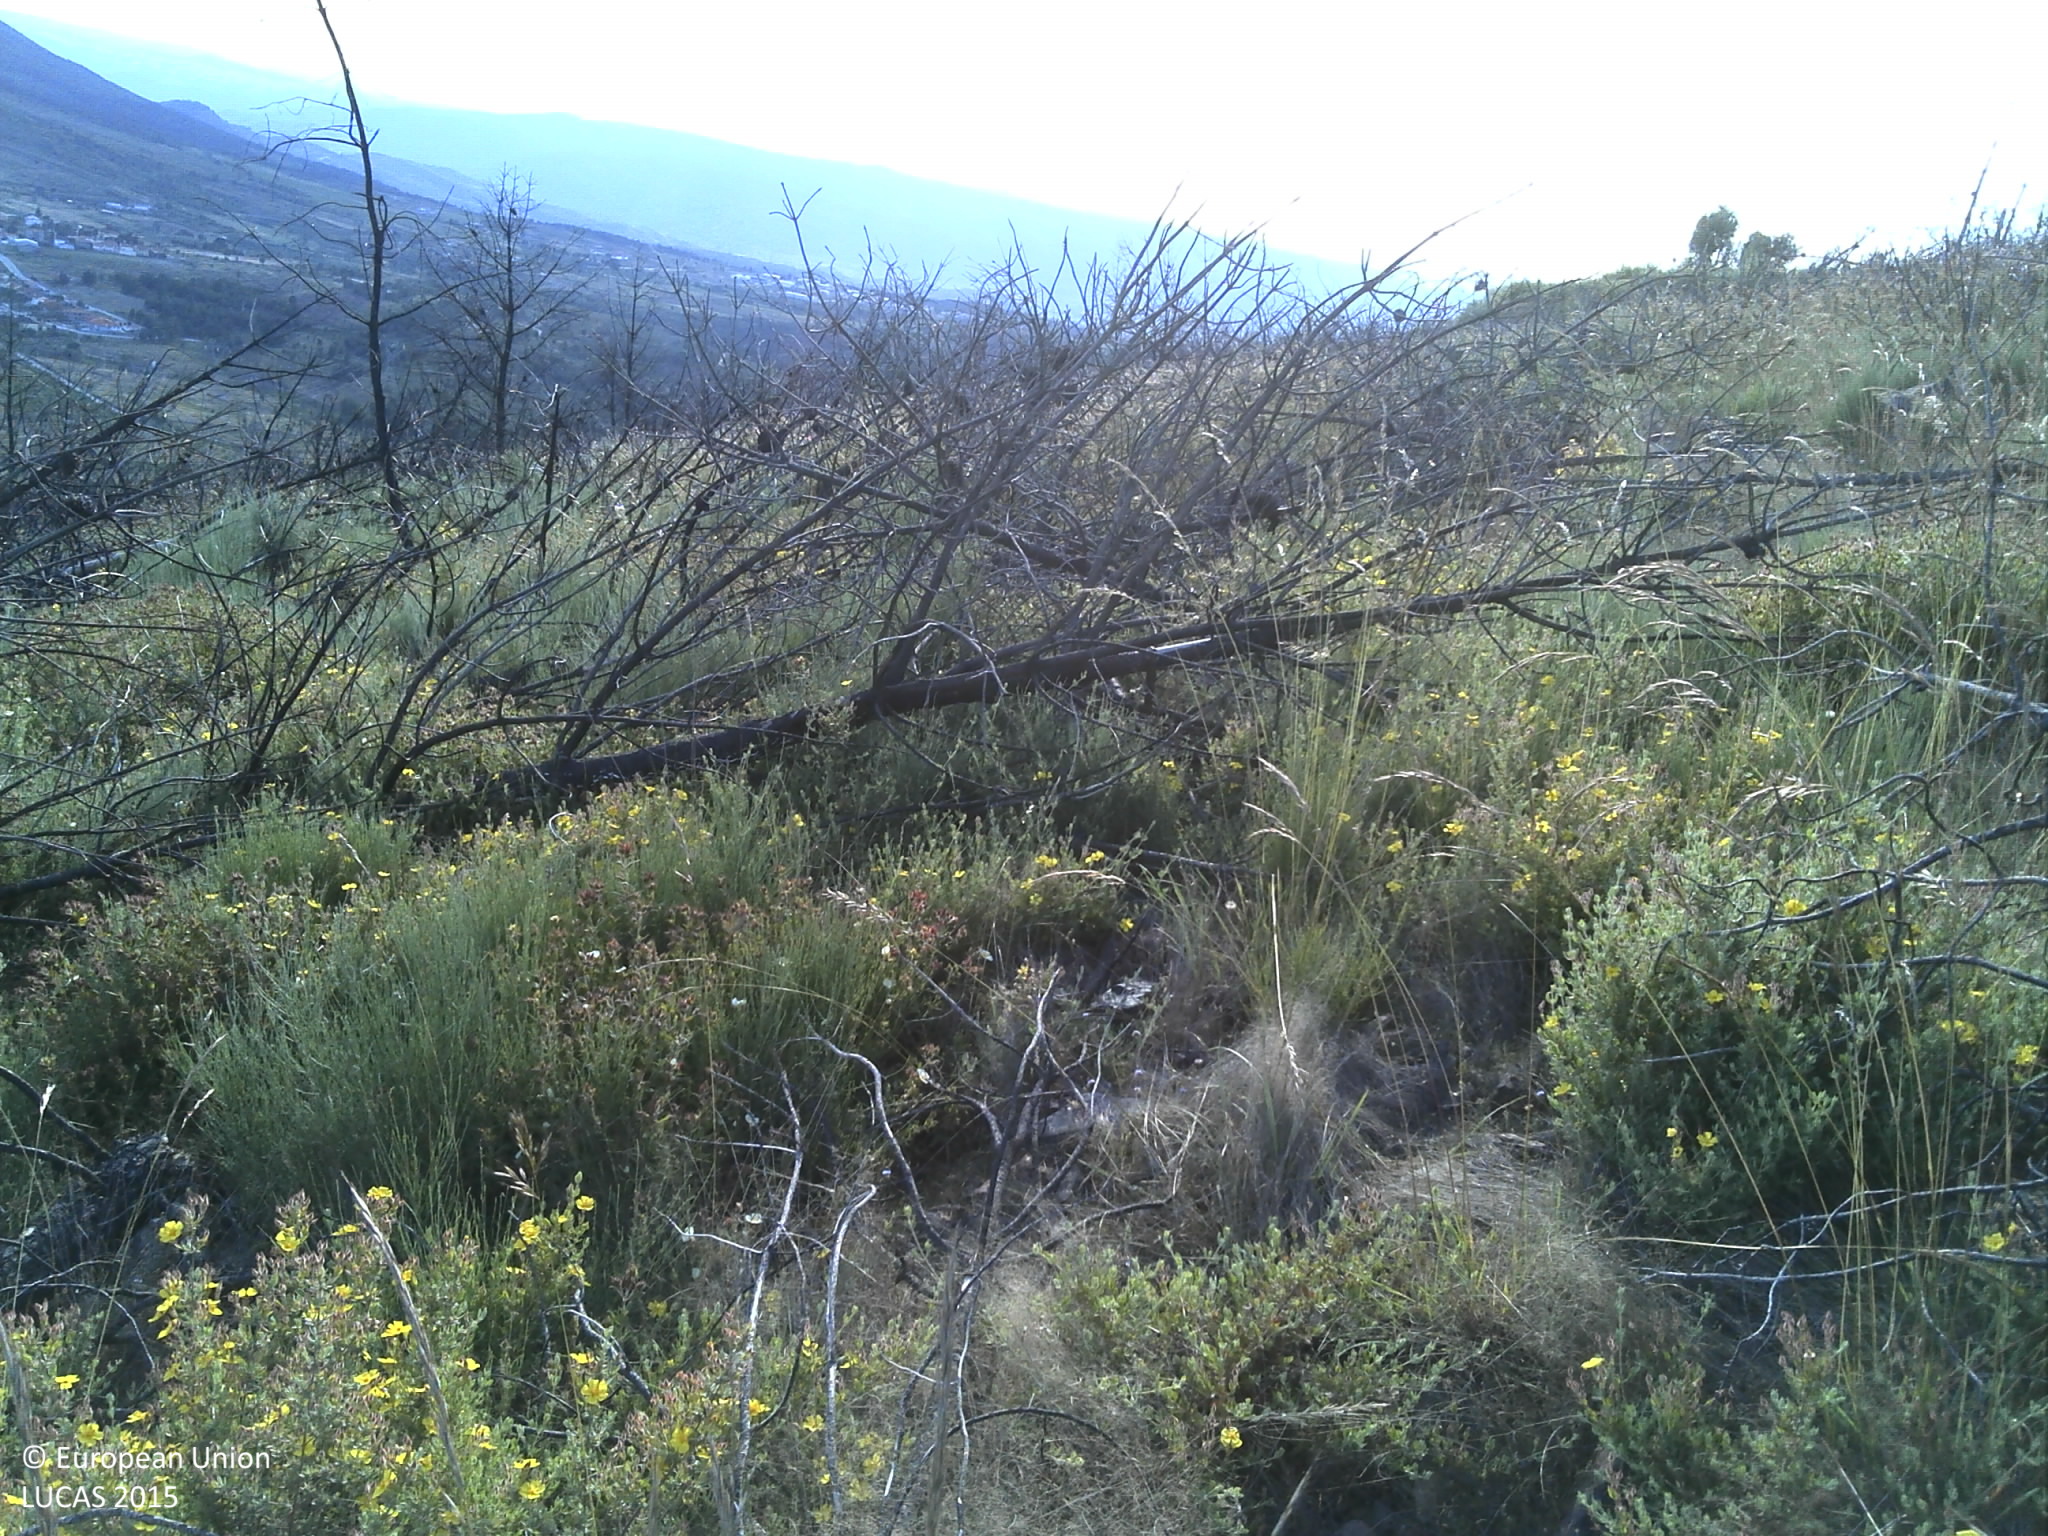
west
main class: Shrubland
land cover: Shrubland without tree cover
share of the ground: > 75 %
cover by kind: shrubs 90 %, herbaceous plants 10 %
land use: Forestry
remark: Burnt area
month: May
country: PT
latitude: 41.1936
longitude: -6.9566
